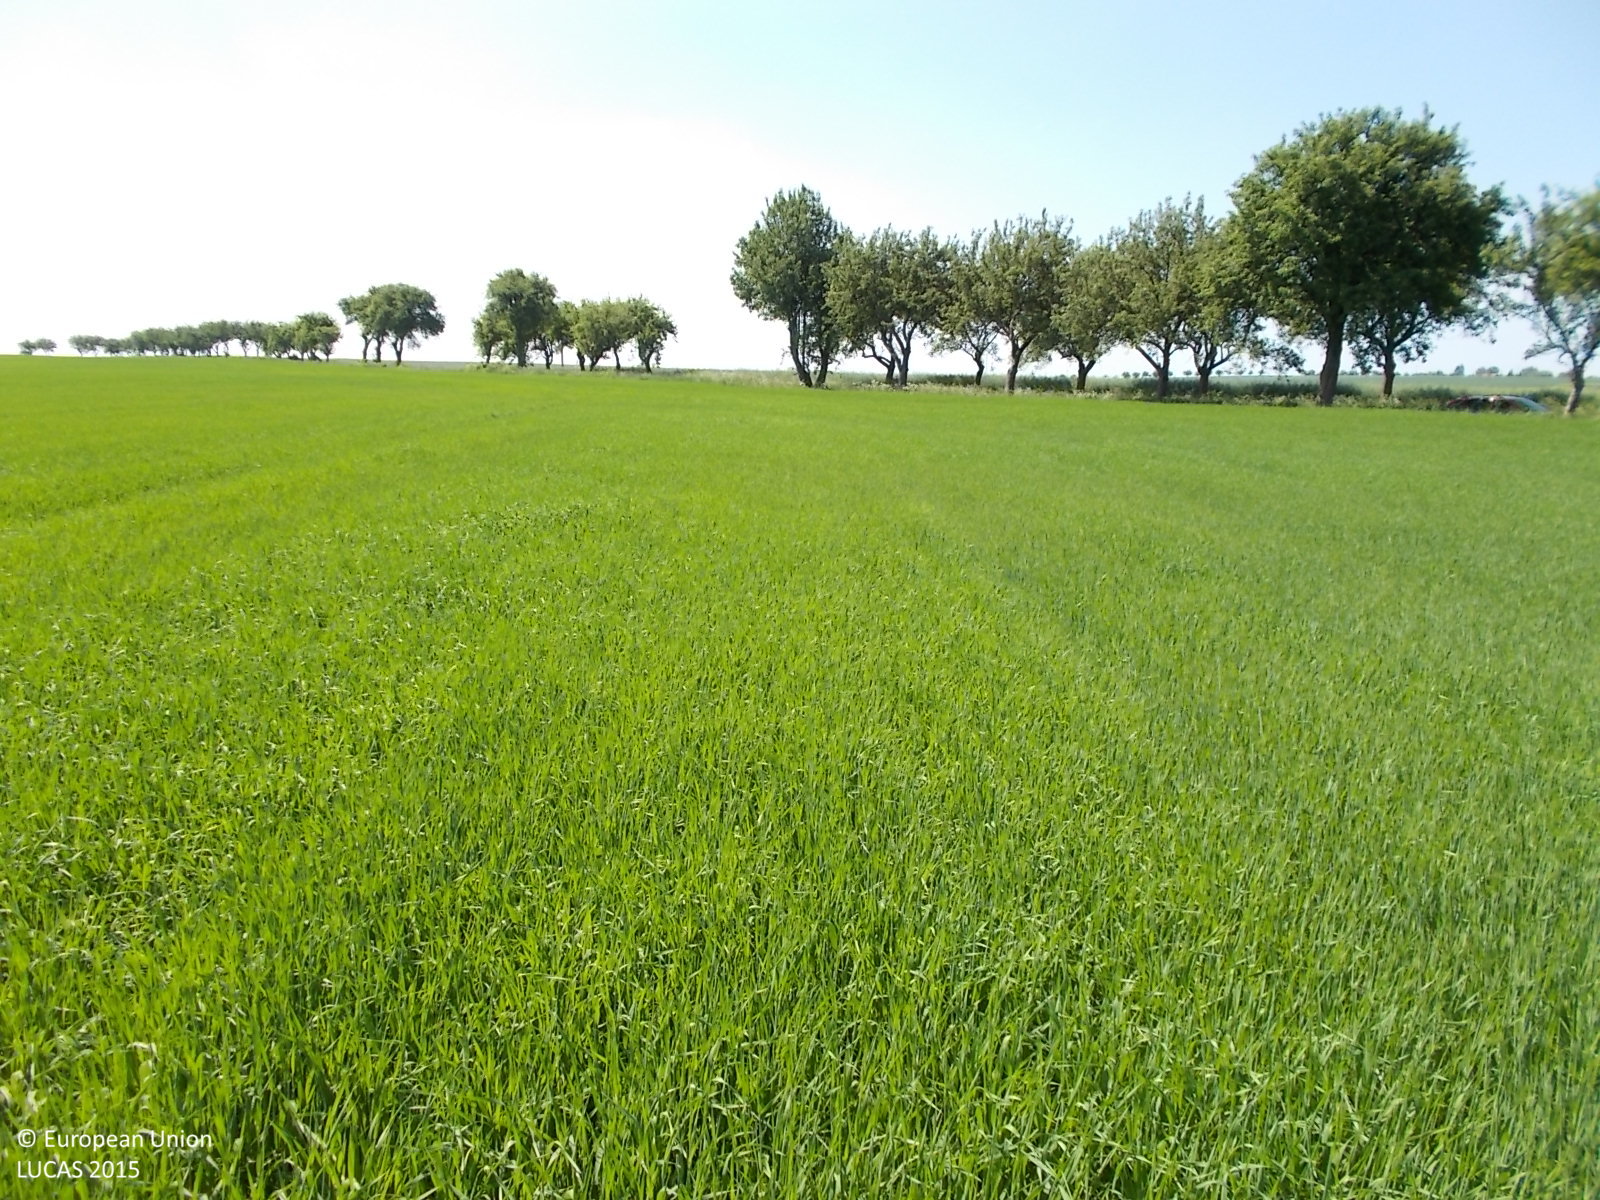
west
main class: Cropland
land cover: Barley
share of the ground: > 75 %
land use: Agriculture (excluding fallow land and kitchen gardens)
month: June
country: CZ
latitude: 49.9061
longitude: 15.1409
